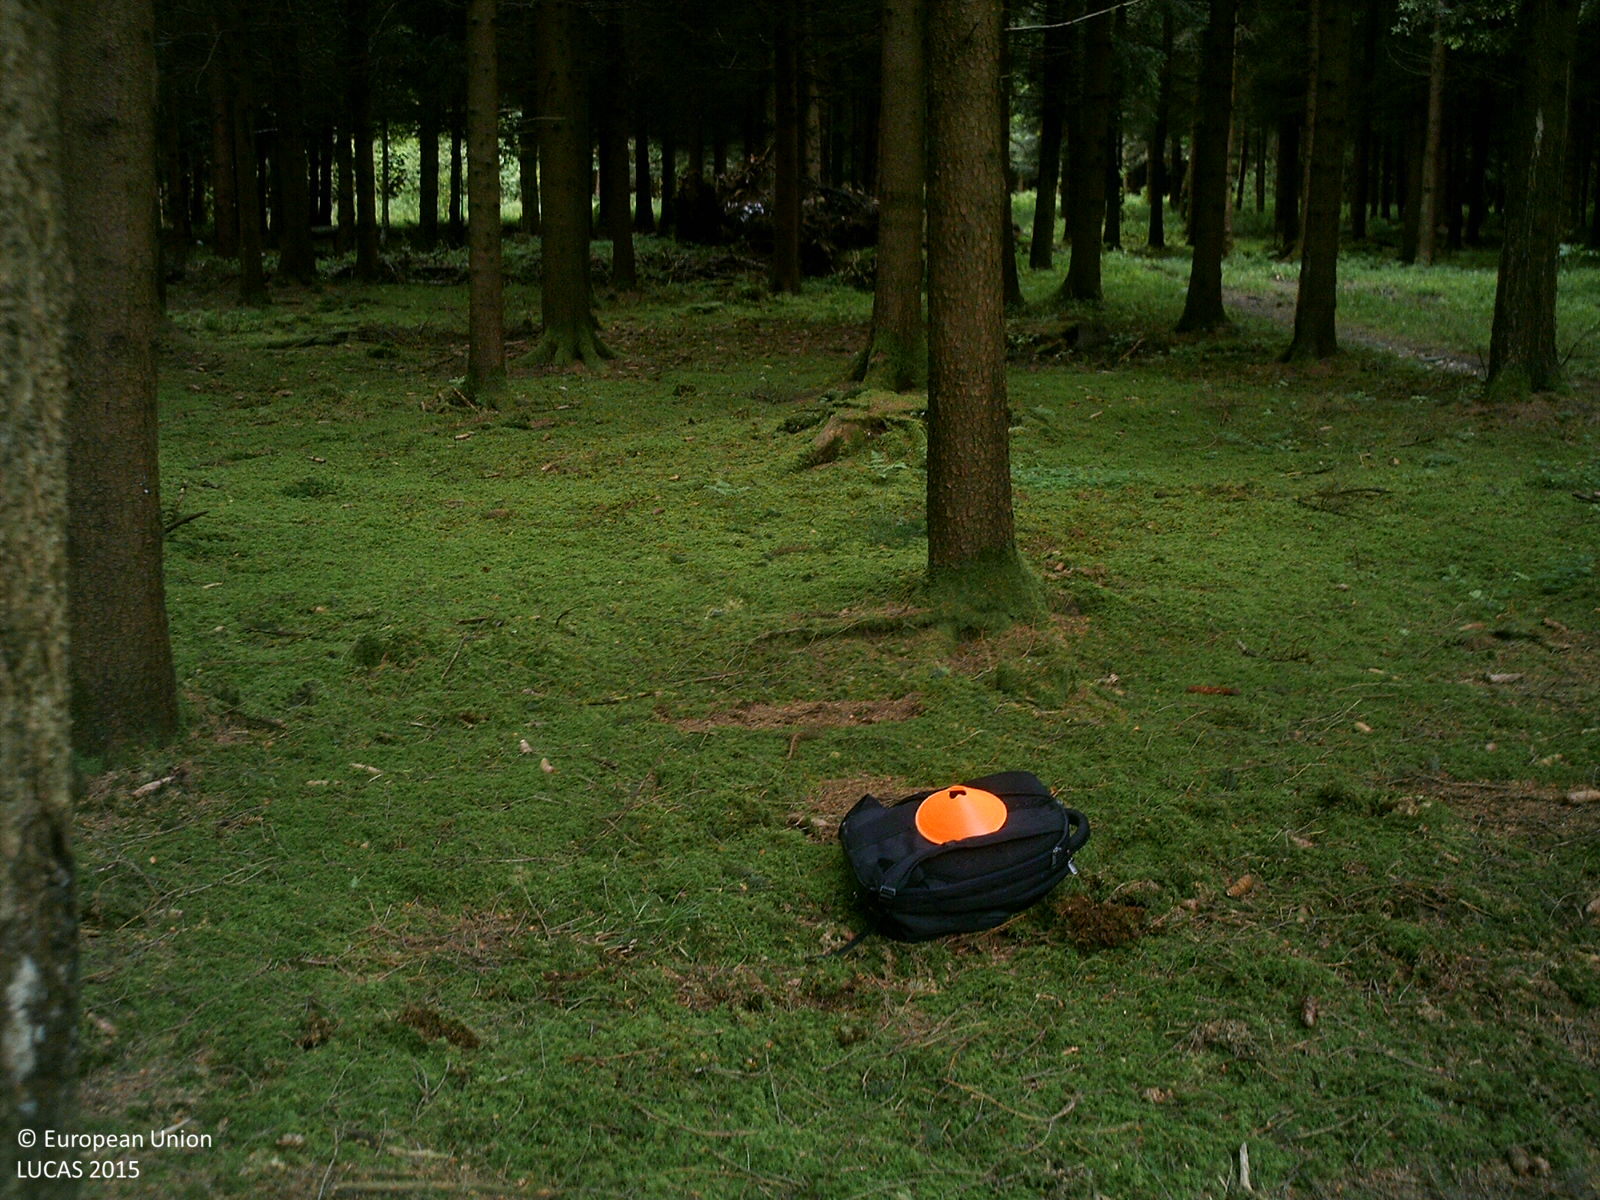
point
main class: Woodland
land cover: Spruce dominated coniferous woodland
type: hemiboreal forest and nemoral coniferous forest and mixed broadleaved-coniferous forest
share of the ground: > 75 %
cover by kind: coniferous forest trees 100 %
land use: Forestry
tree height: > 5 m
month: May
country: AT
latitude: 48.1454
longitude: 14.1528
